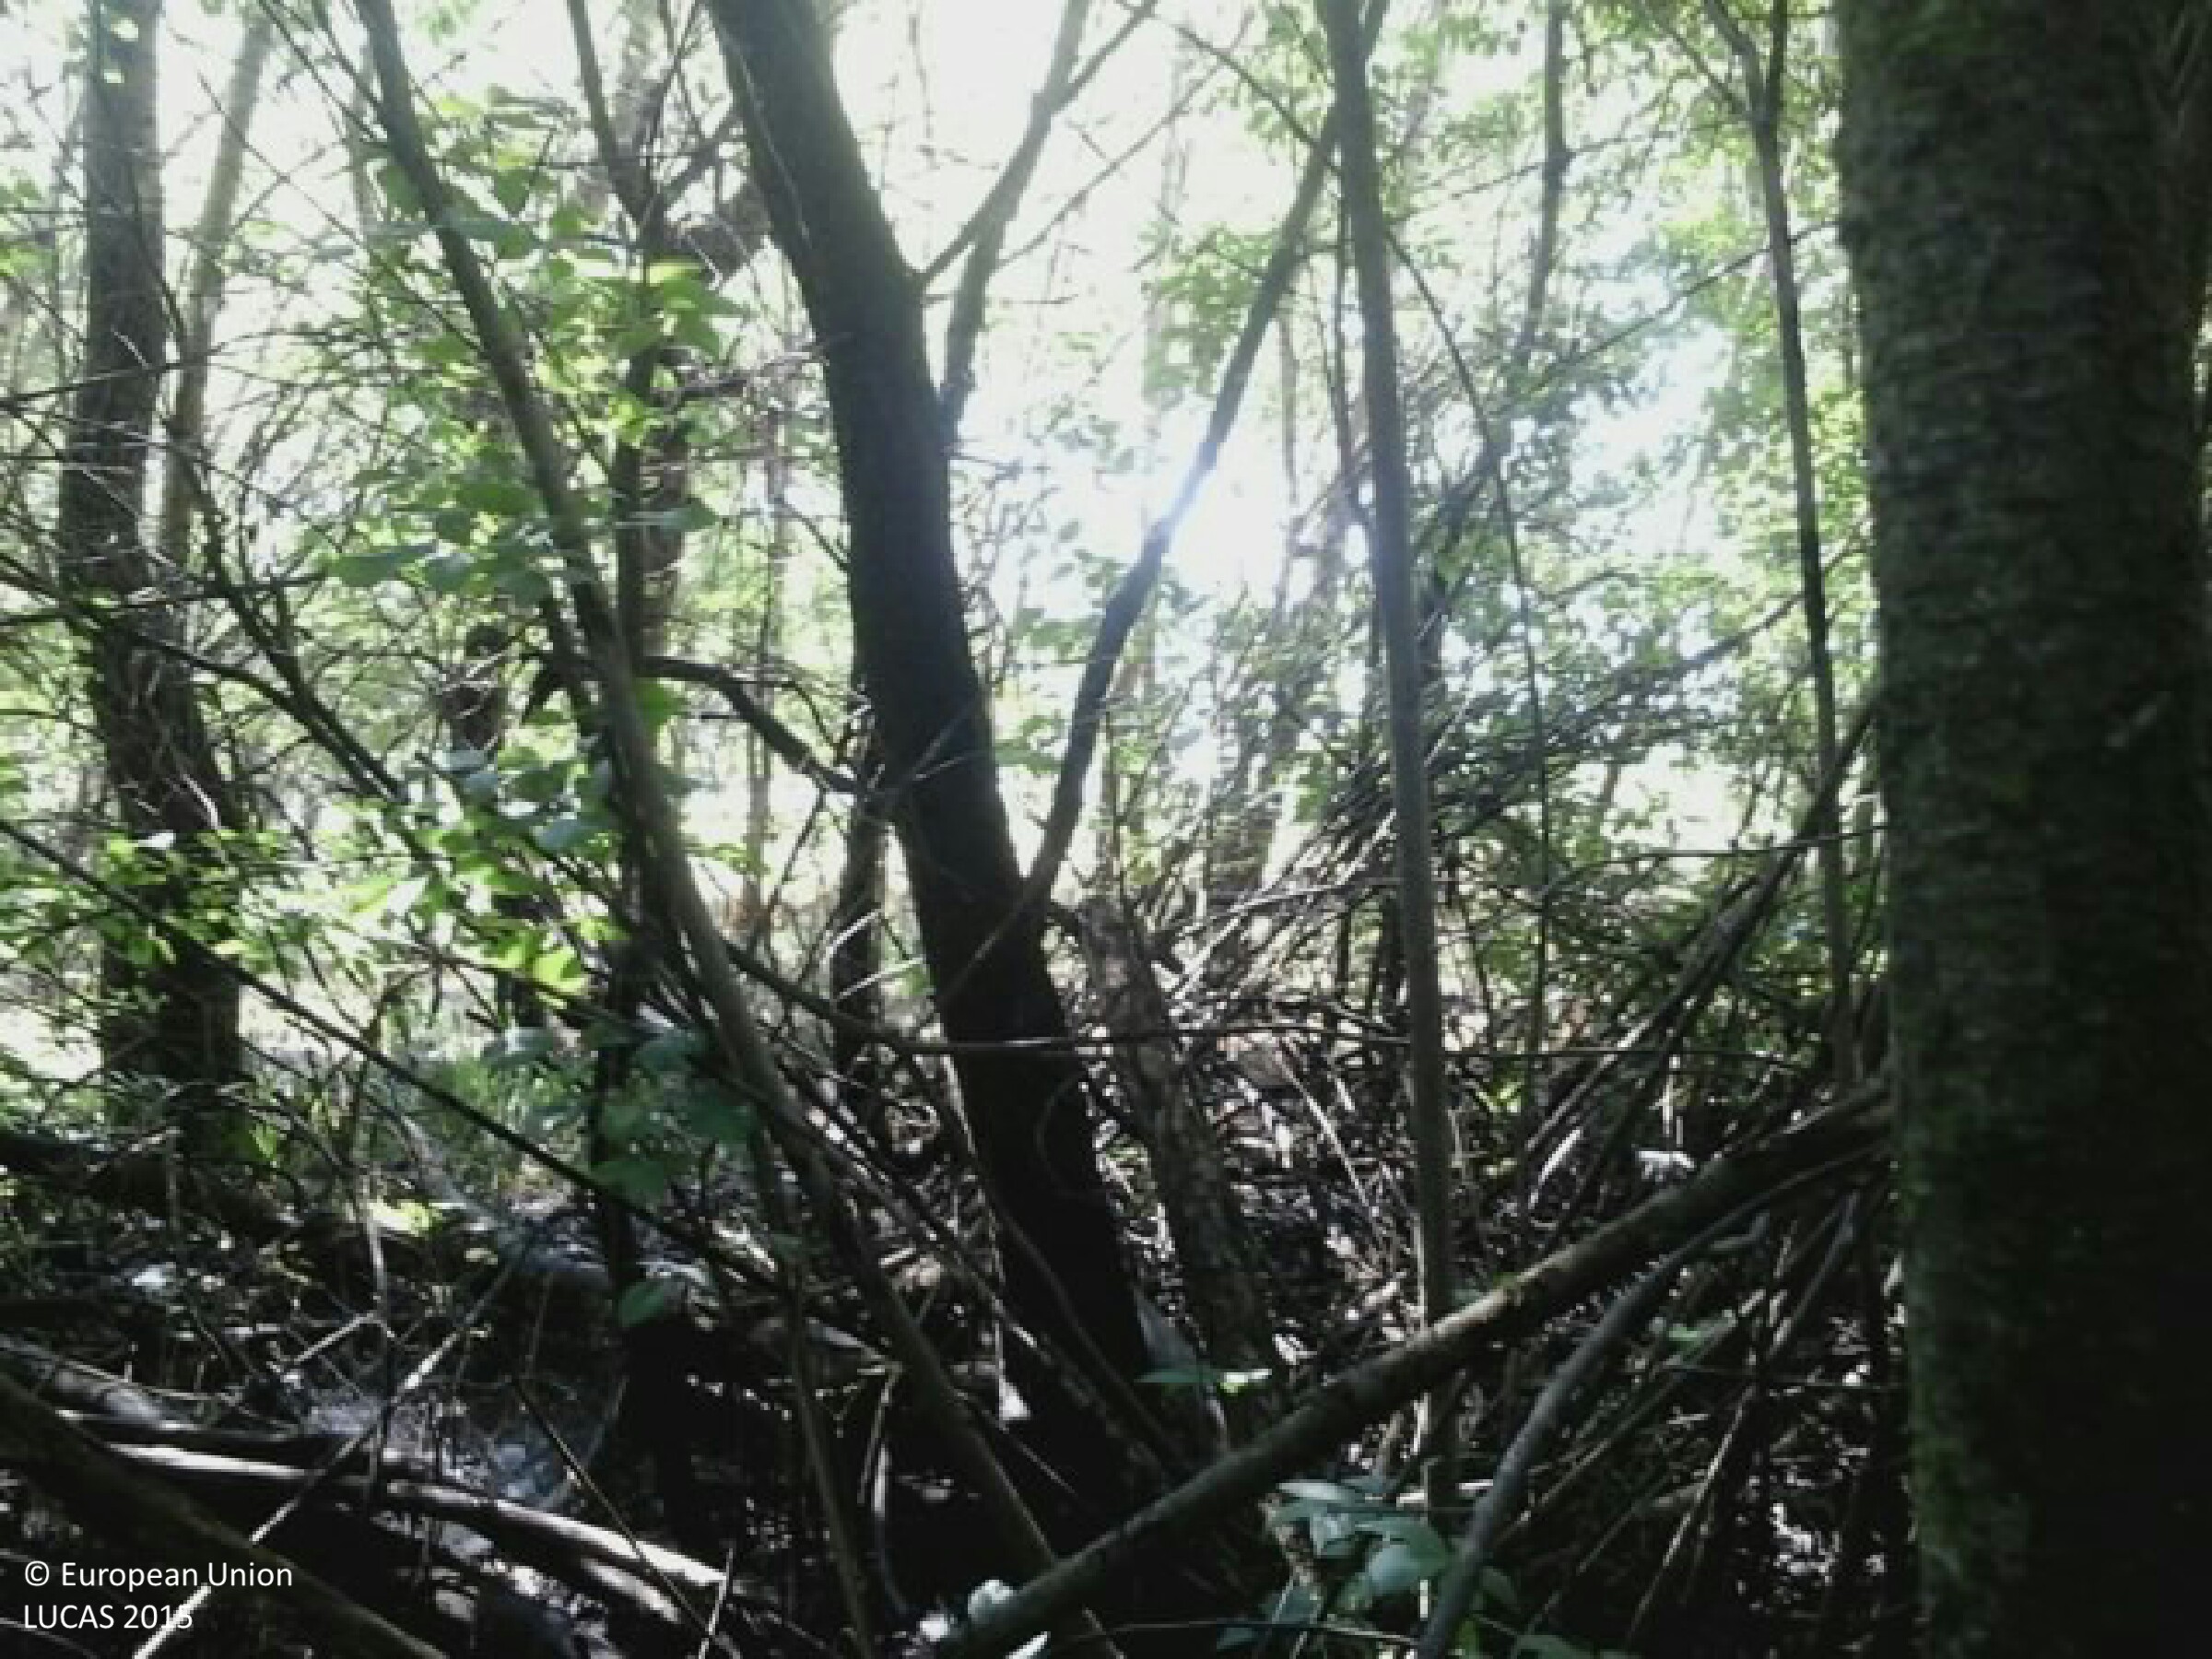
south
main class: Woodland
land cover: Broadleaved woodland
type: mesophytic deciduous forest
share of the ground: > 75 %
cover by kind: broadleaved forest trees 85 %, shrubs 10 %, herbaceous plants 5 %
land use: Forestry
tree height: > 5 m
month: August
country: HU
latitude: 47.1613
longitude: 19.6906
